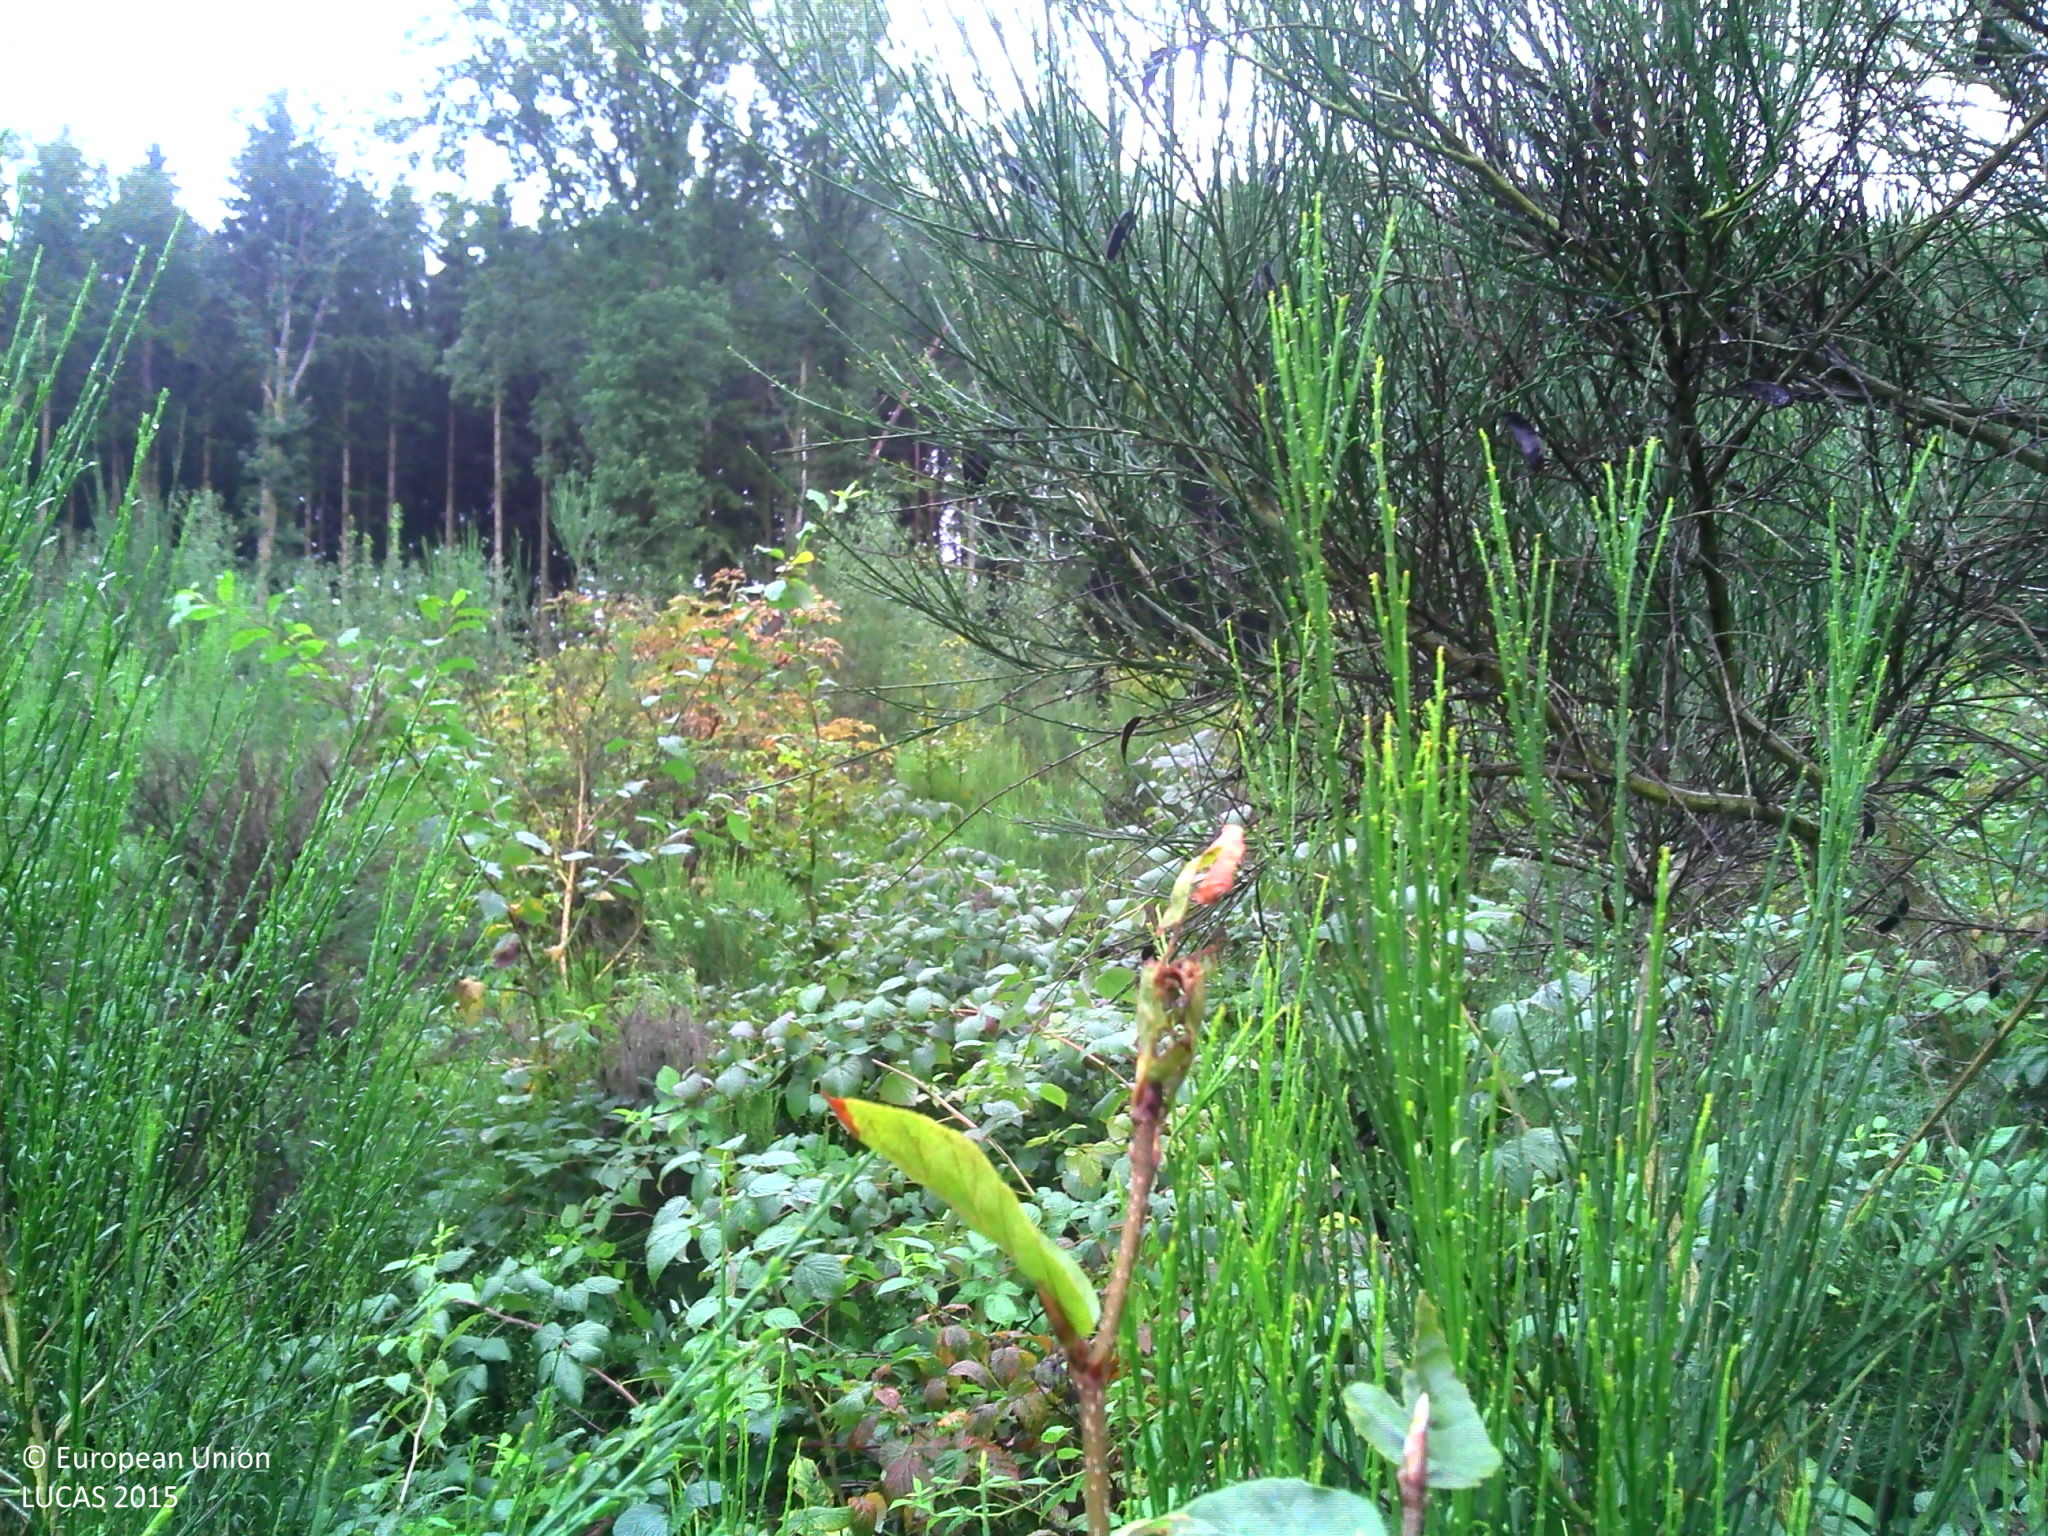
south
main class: Shrubland
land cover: Shrubland with sparse tree cover
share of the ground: > 75 %
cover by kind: shrubs 95 %, broadleaved forest trees 5 %
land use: Forestry
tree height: < 5 m
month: September
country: LU
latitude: 49.8045
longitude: 5.9001
